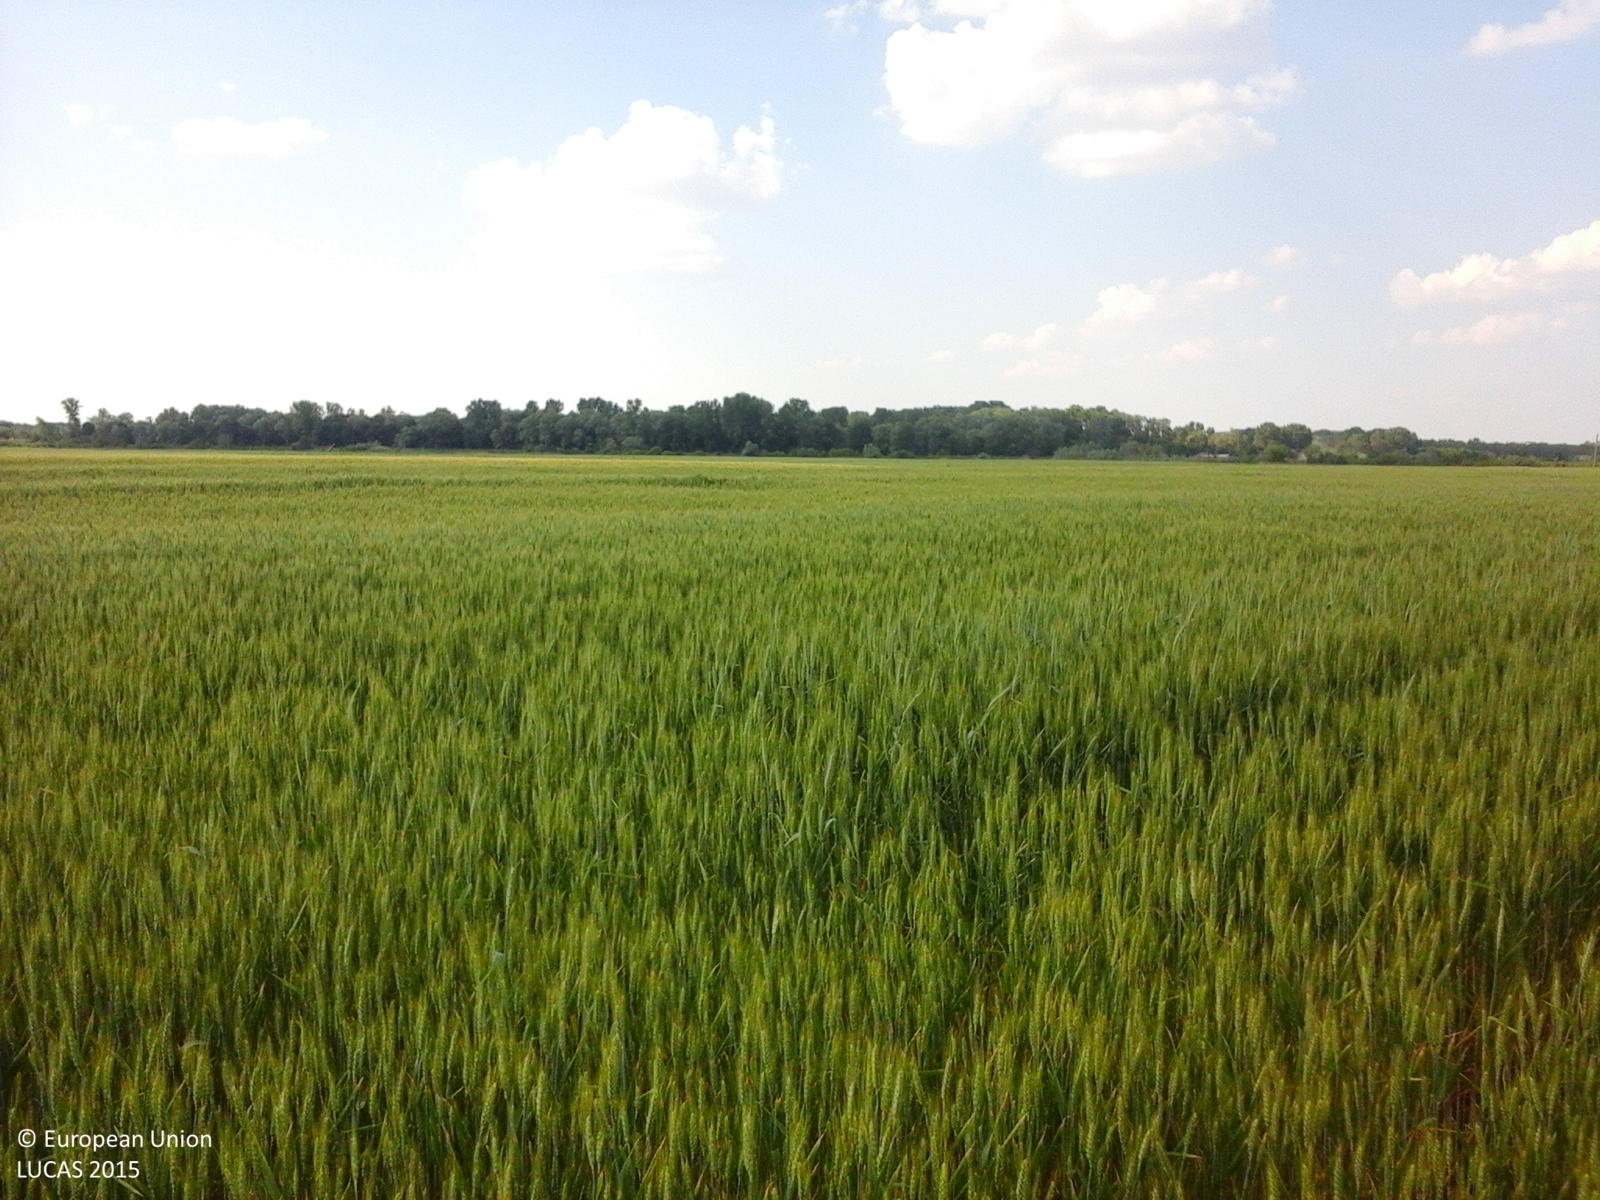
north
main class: Cropland
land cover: Durum wheat
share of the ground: > 75 %
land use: Agriculture (excluding fallow land and kitchen gardens)
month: June
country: RO
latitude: 47.0950
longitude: 26.8676
